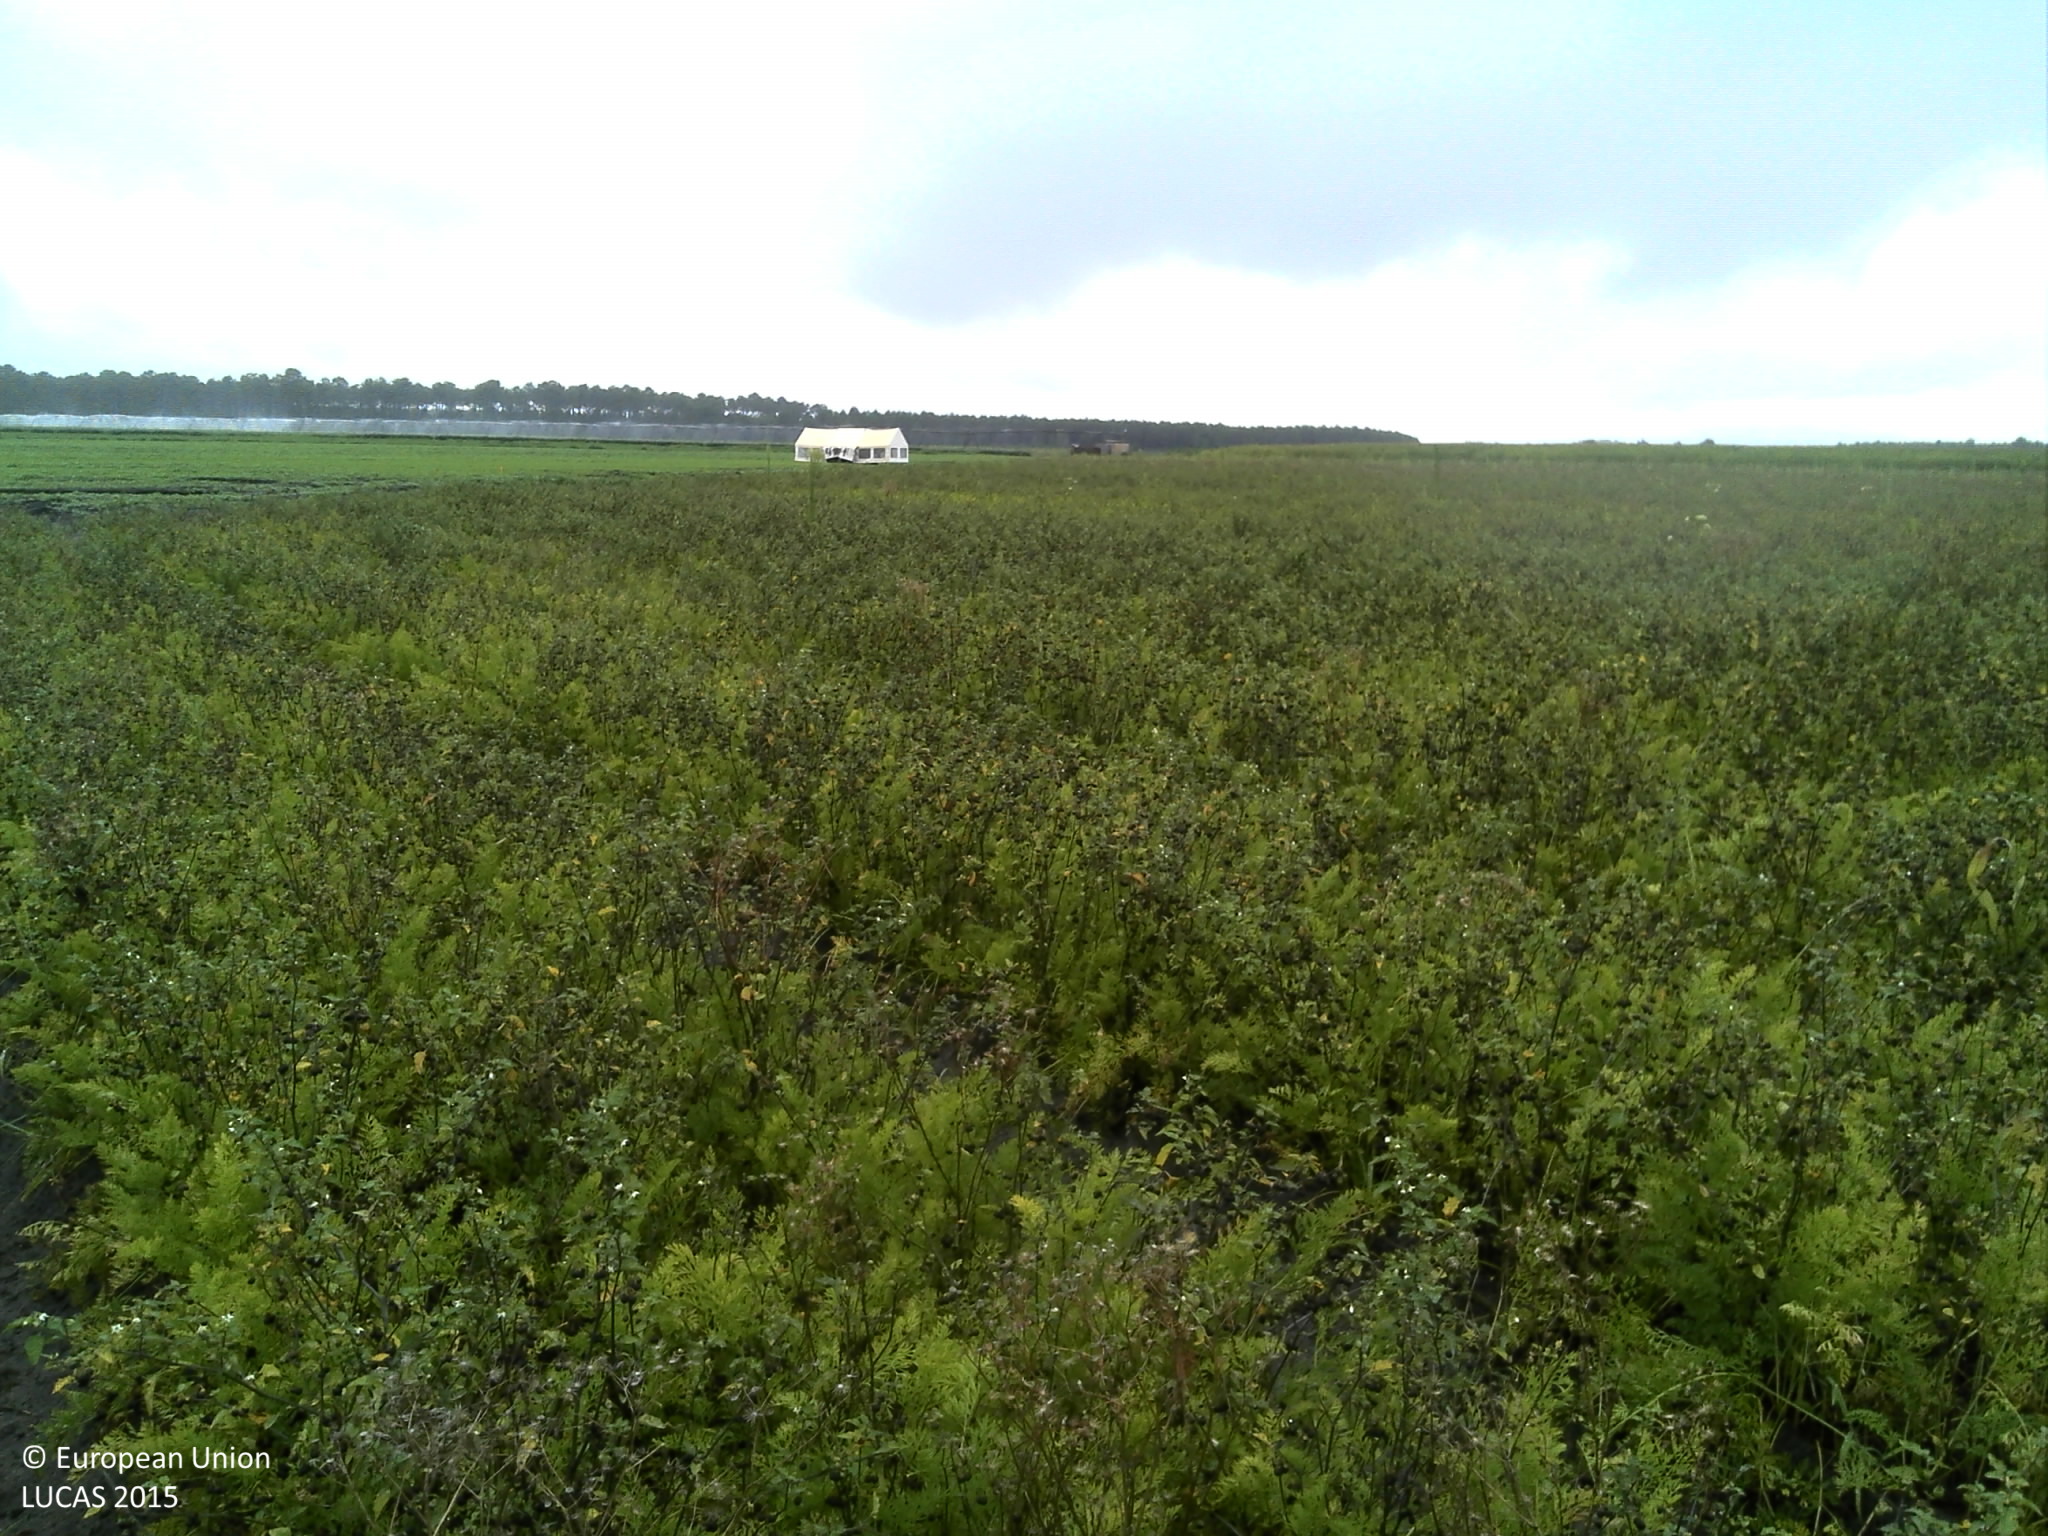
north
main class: Cropland
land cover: Other root crops
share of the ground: > 75 %
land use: Agriculture (excluding fallow land and kitchen gardens)
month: August
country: FR
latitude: 44.4487
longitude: -0.8887
